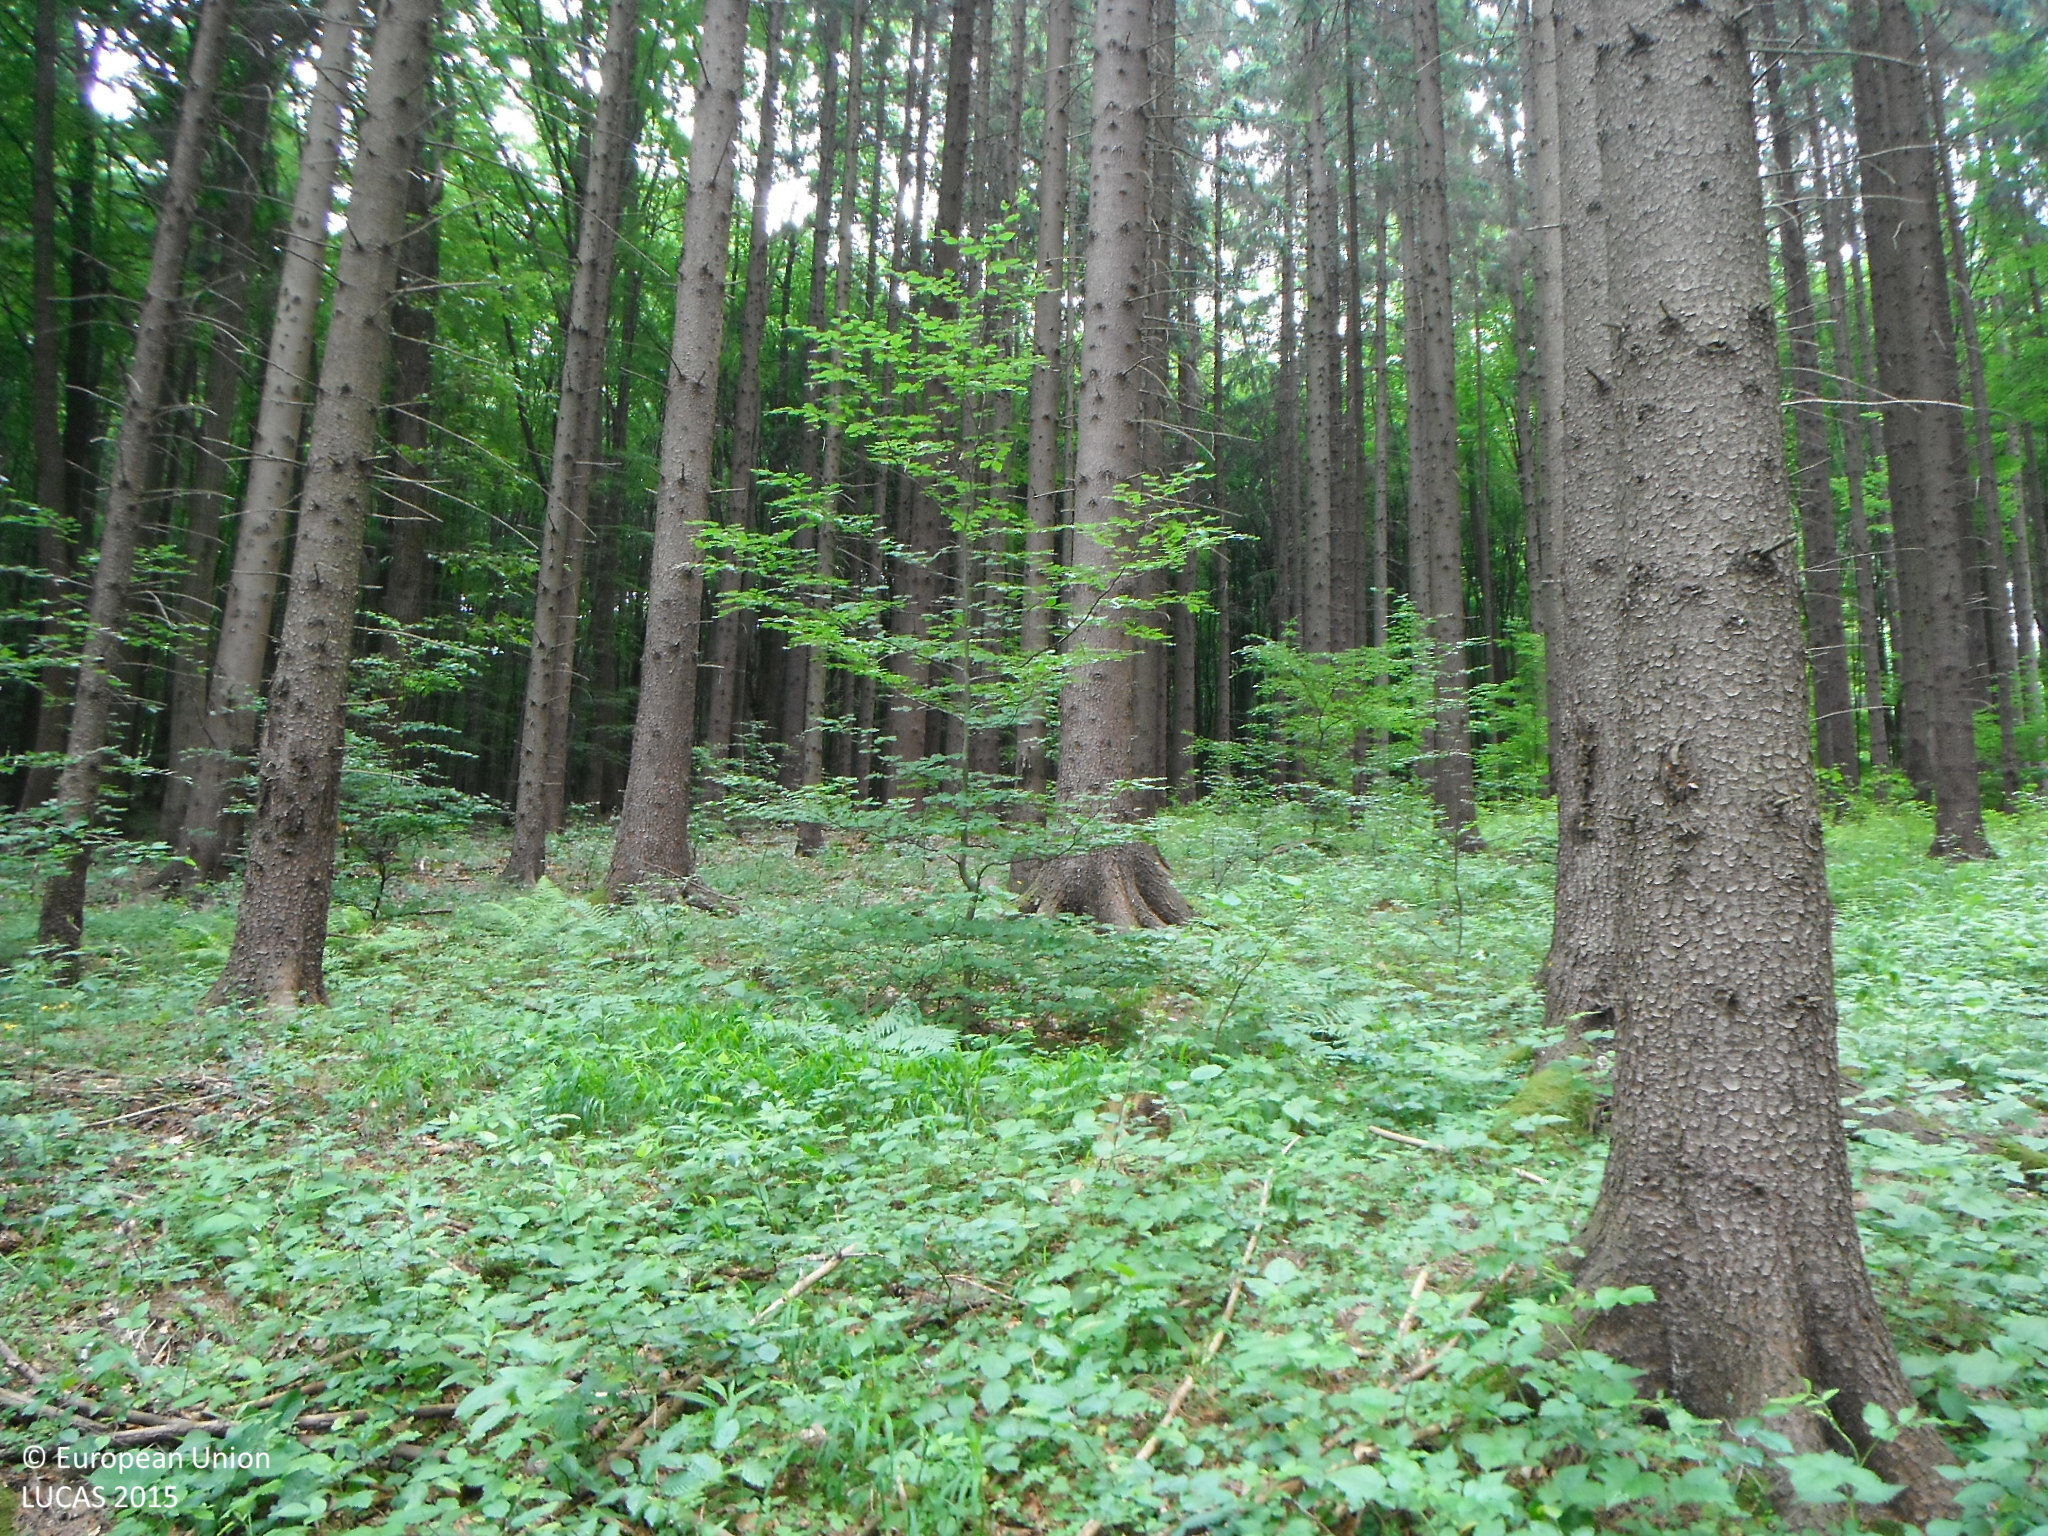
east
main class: Woodland
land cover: Spruce dominated coniferous woodland
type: alpine coniferous forest
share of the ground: > 75 %
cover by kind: coniferous forest trees 90 %, shrubs 5 %, herbaceous plants 5 %
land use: Forestry
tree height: > 5 m
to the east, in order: Spruce dominated coniferous woodland; Broadleaved woodland; Rocks and stones; Broadleaved woodland
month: June
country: SK
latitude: 48.6206
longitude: 19.3709
